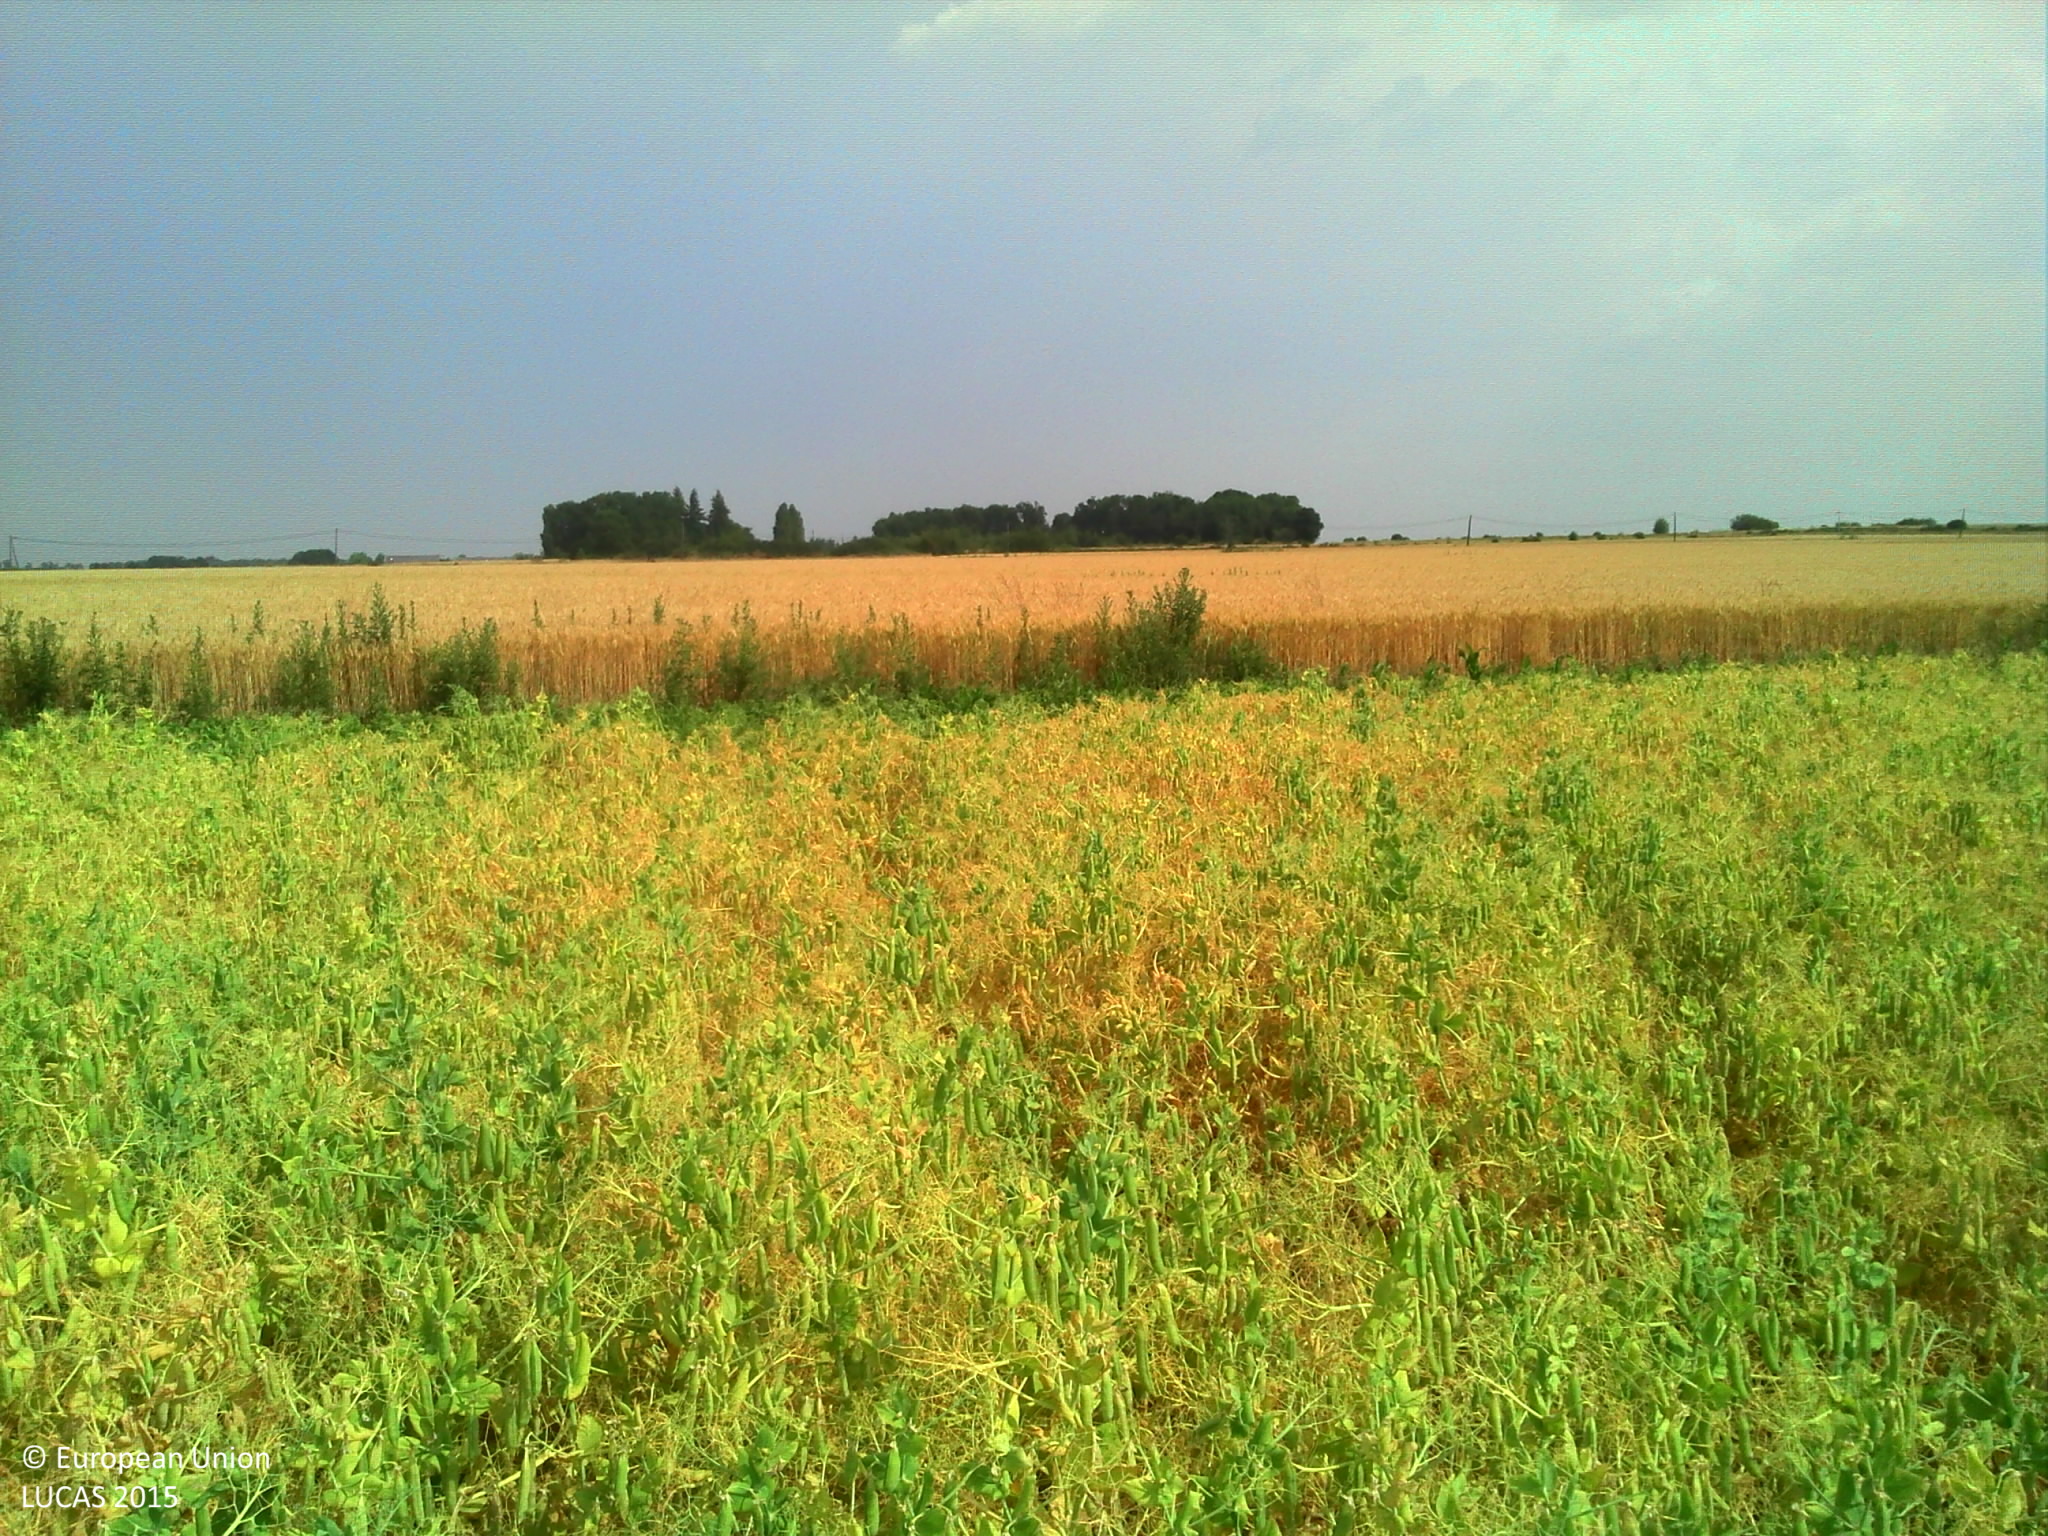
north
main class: Cropland
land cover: Dry pulses
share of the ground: > 75 %
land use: Agriculture (excluding fallow land and kitchen gardens)
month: July
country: FR
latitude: 48.8876
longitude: 1.2384
